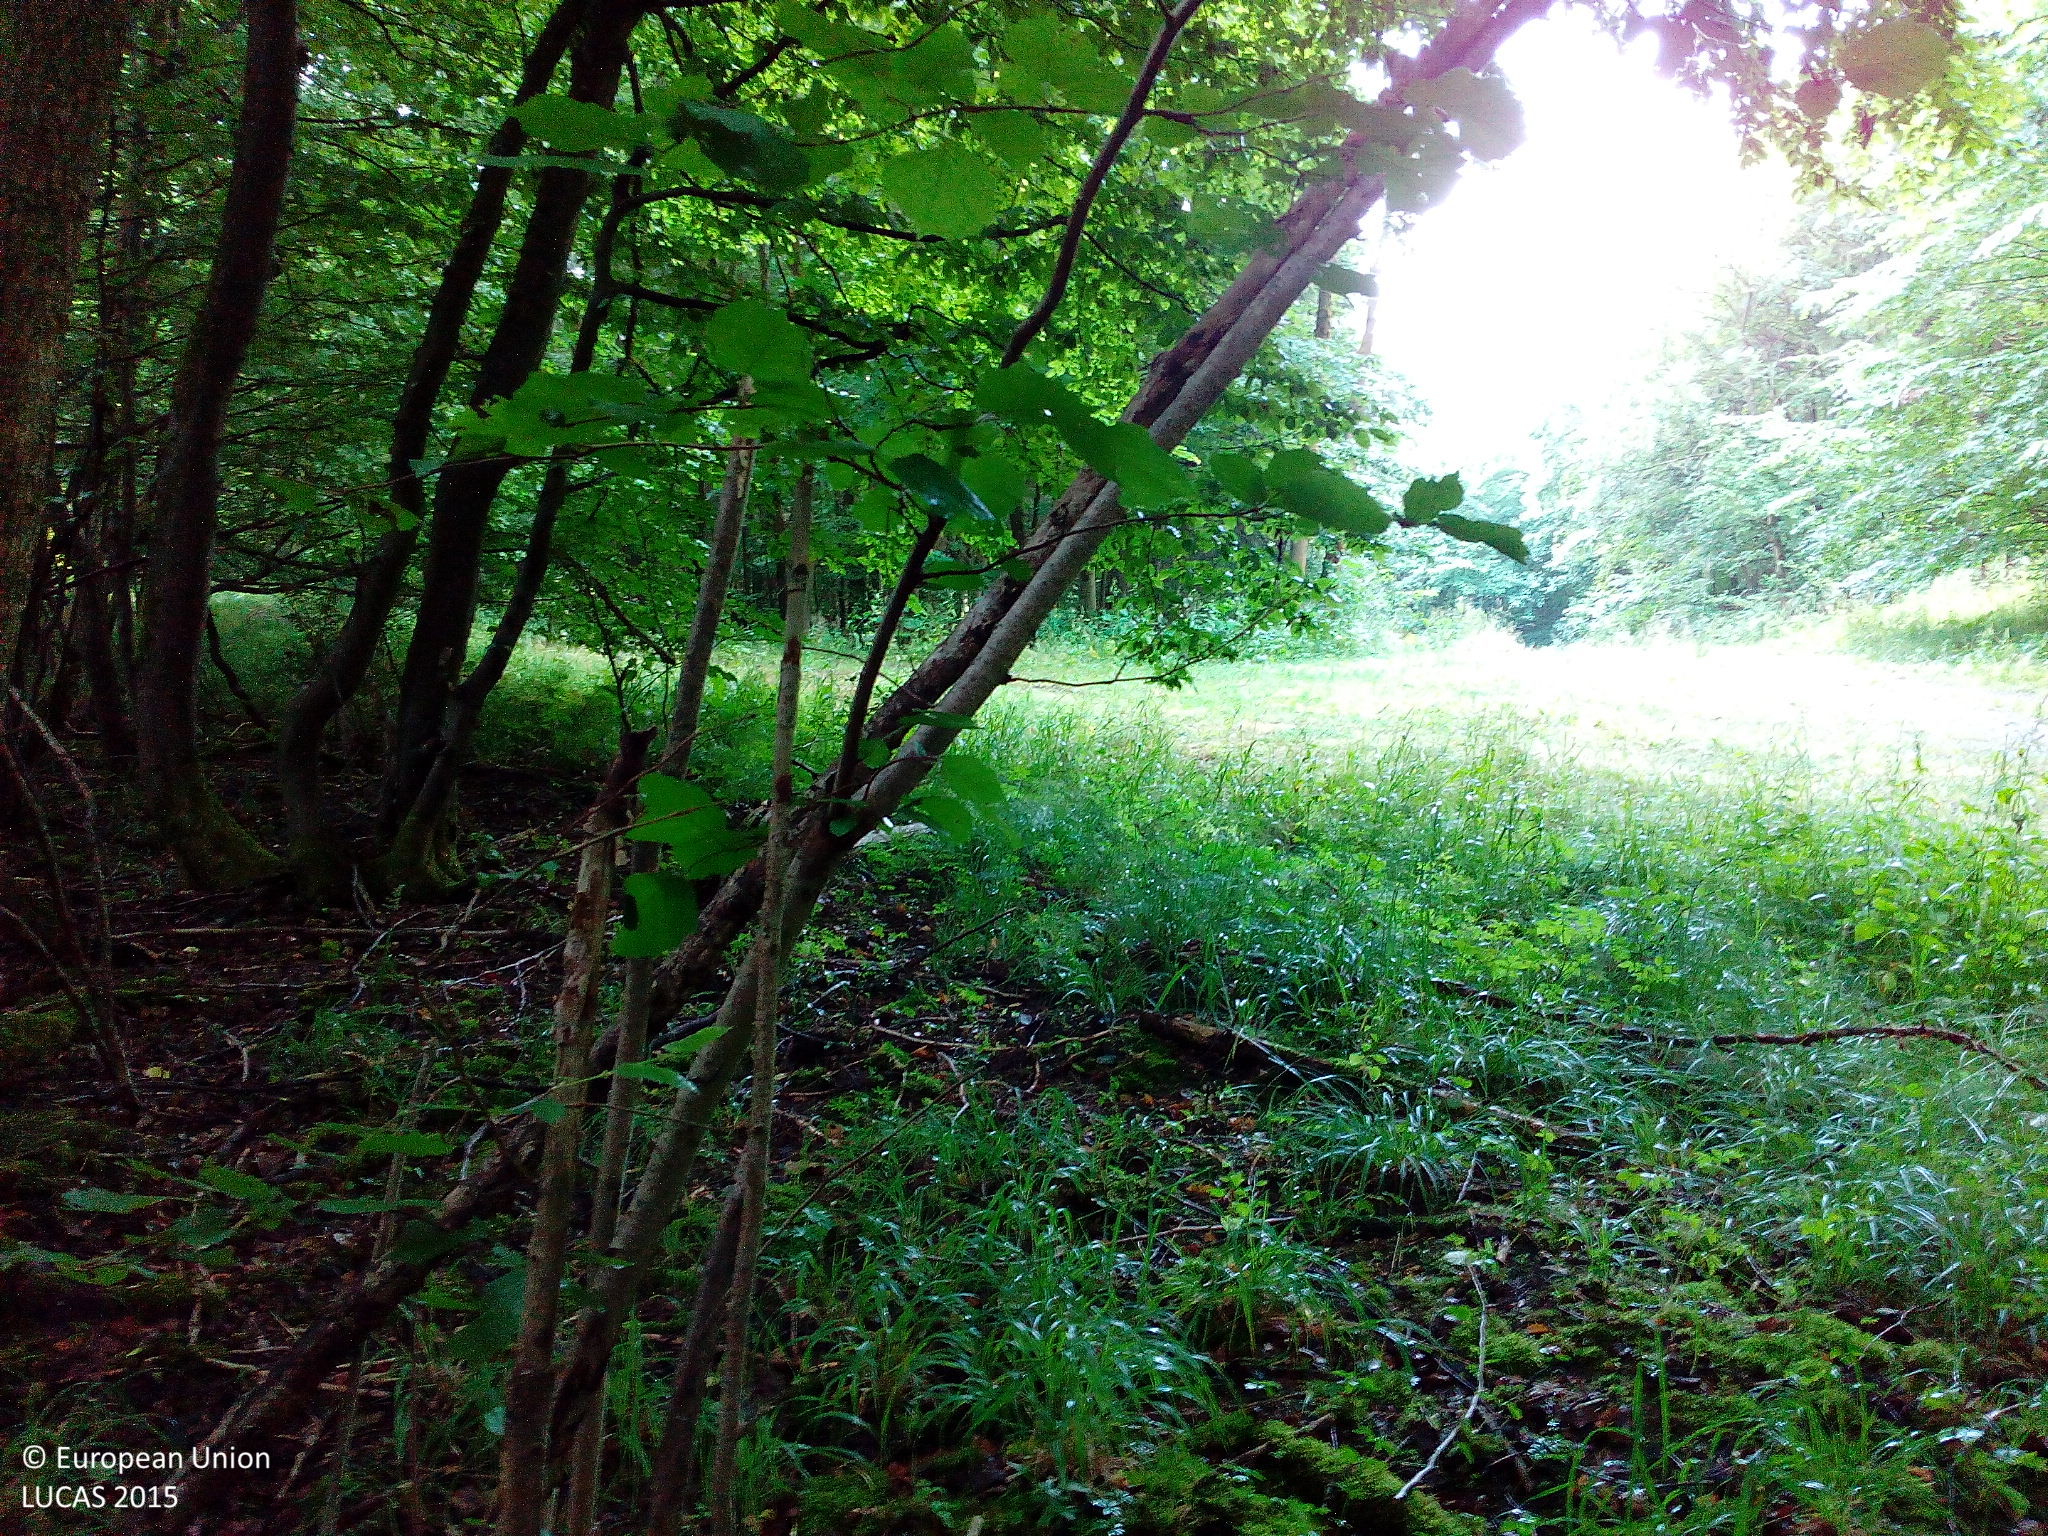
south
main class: Woodland
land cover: Broadleaved woodland
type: acidophilous oak and oak-birch forest
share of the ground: > 75 %
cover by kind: broadleaved forest trees 100 %
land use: Forestry
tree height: > 5 m
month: July
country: DE
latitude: 50.6696
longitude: 9.8727
